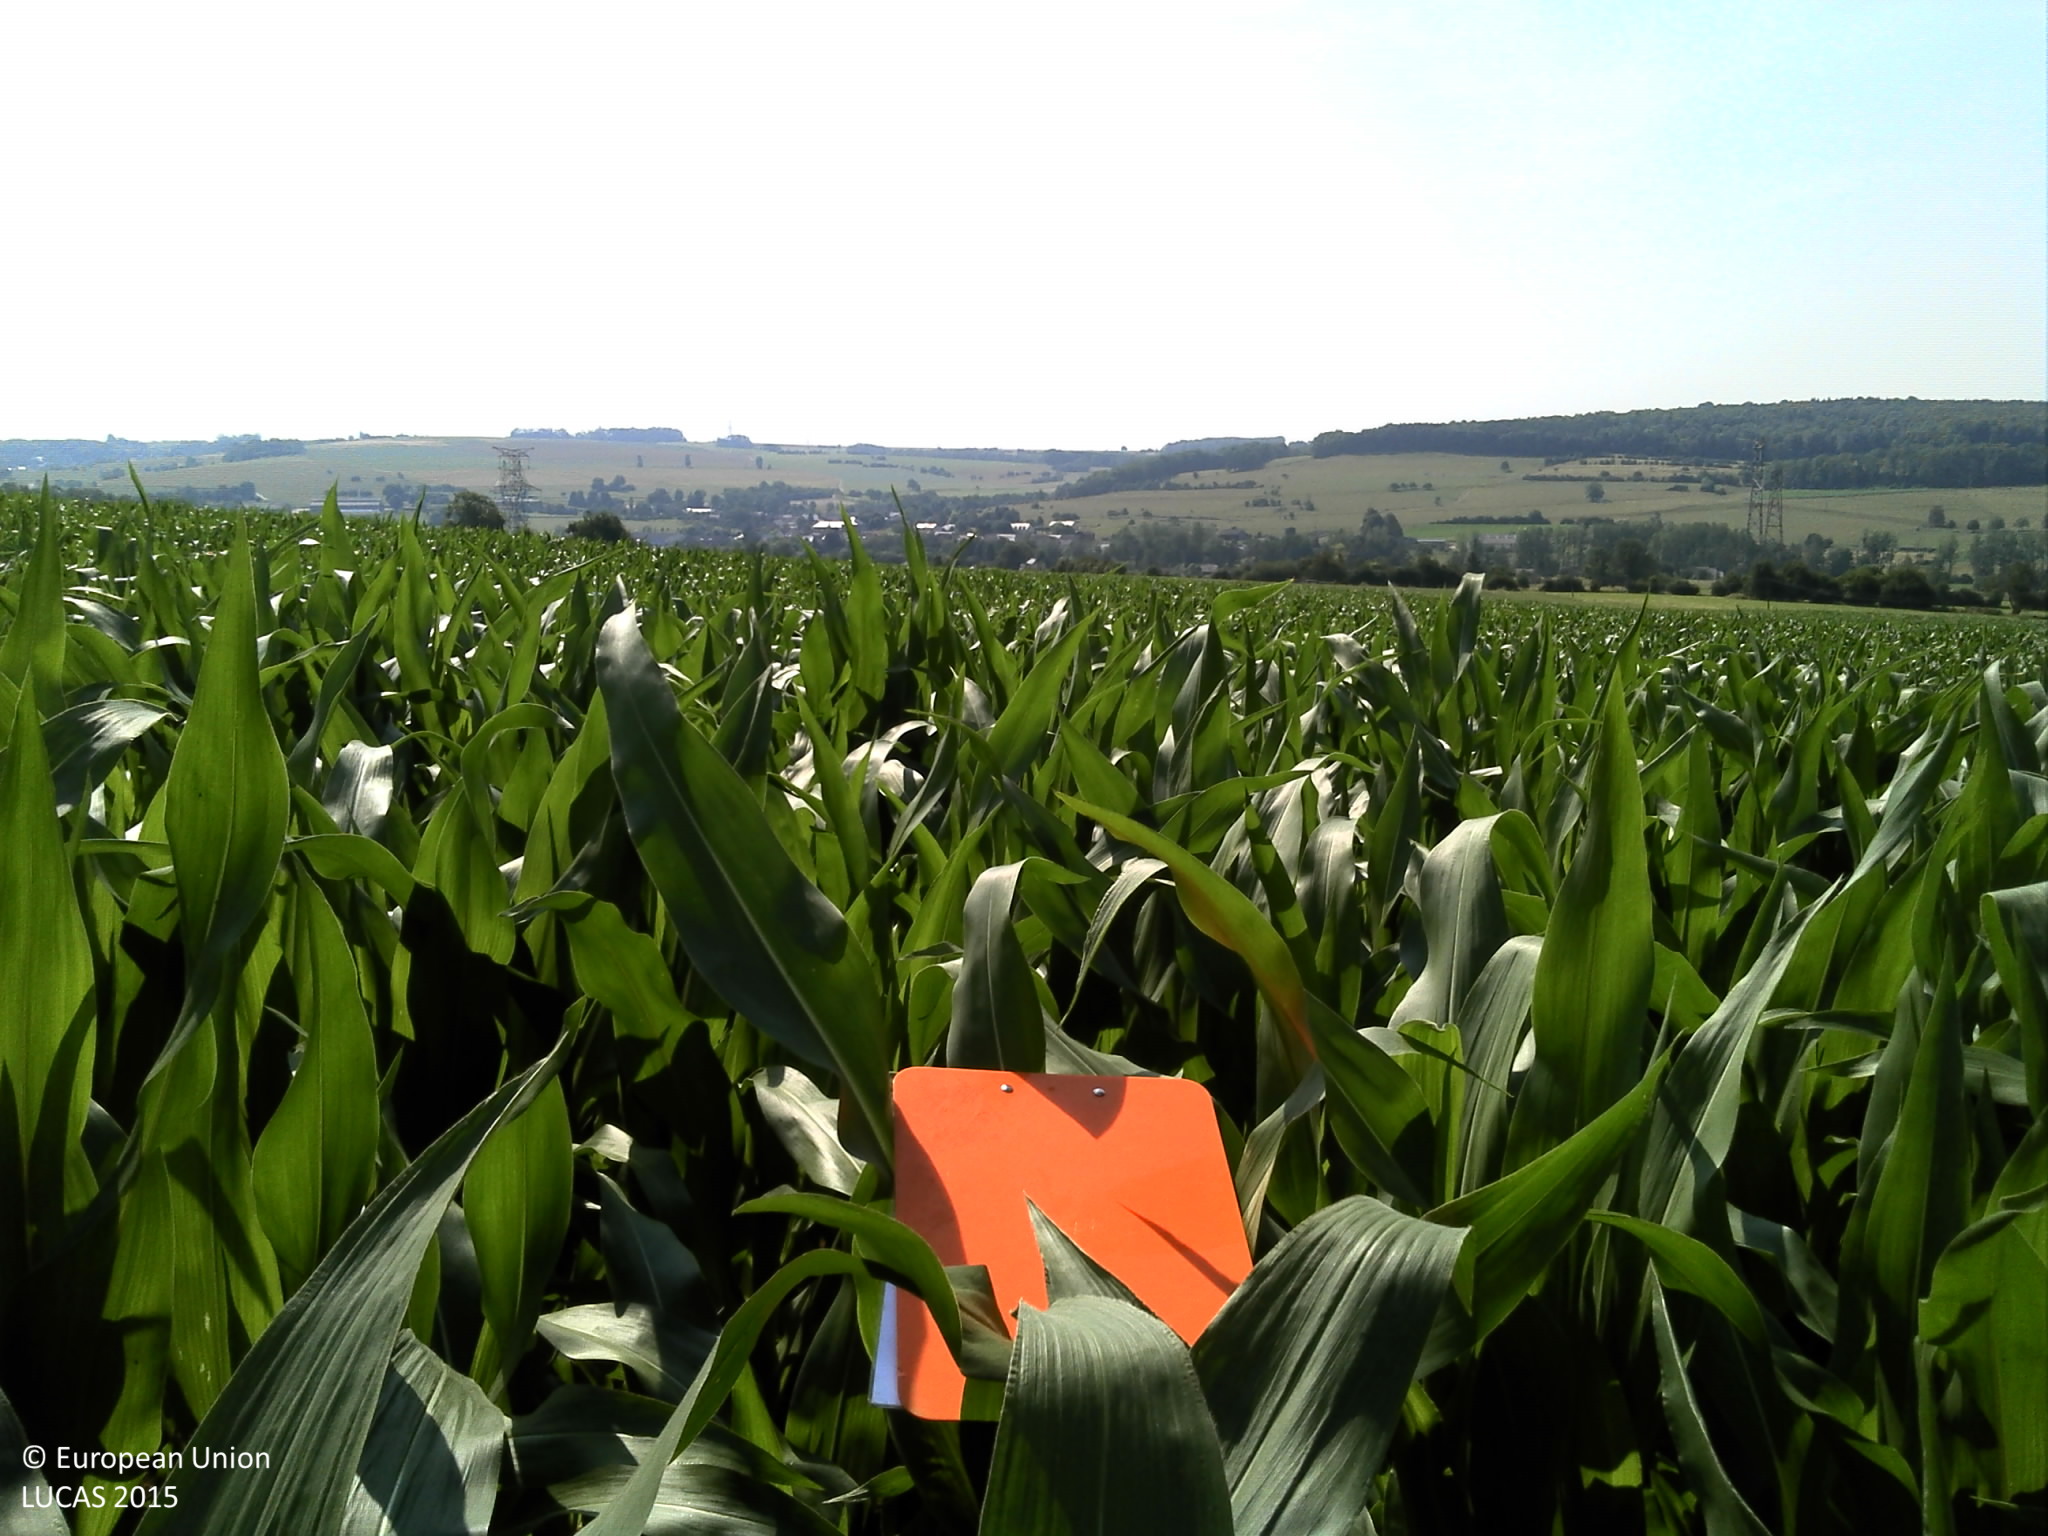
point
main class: Cropland
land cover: Maize
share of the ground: > 75 %
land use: Agriculture (excluding fallow land and kitchen gardens)
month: July
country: FR
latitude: 49.7982
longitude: 4.4806
